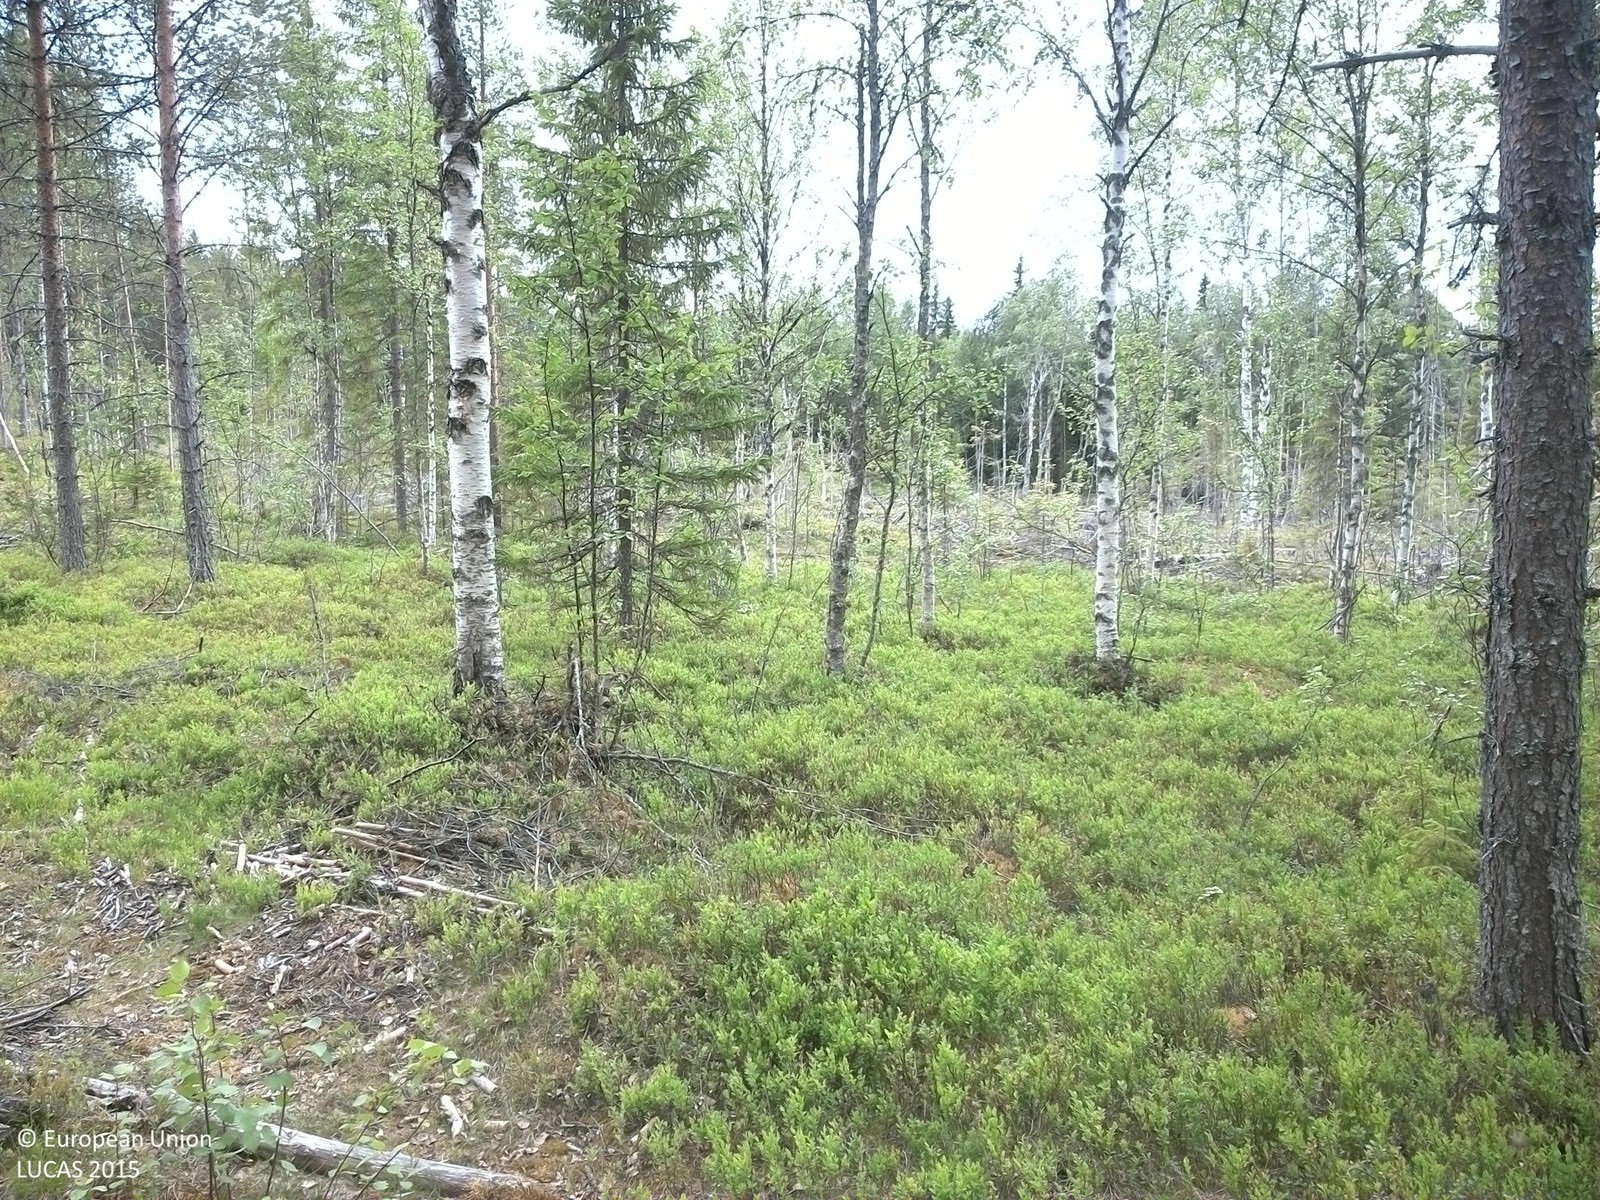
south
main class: Woodland
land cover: Pine dominated mixed woodland
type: boreal forest
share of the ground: 25 - 50 %
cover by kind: coniferous forest trees 35 %, shrubs 30 %, broadleaved forest trees 15 %, lichens and mosses 10 %, herbaceous plants 5 %, unconsolidated bare surface 5 %
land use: Forestry
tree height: > 5 m
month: July
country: SE
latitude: 64.1986
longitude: 16.7854
